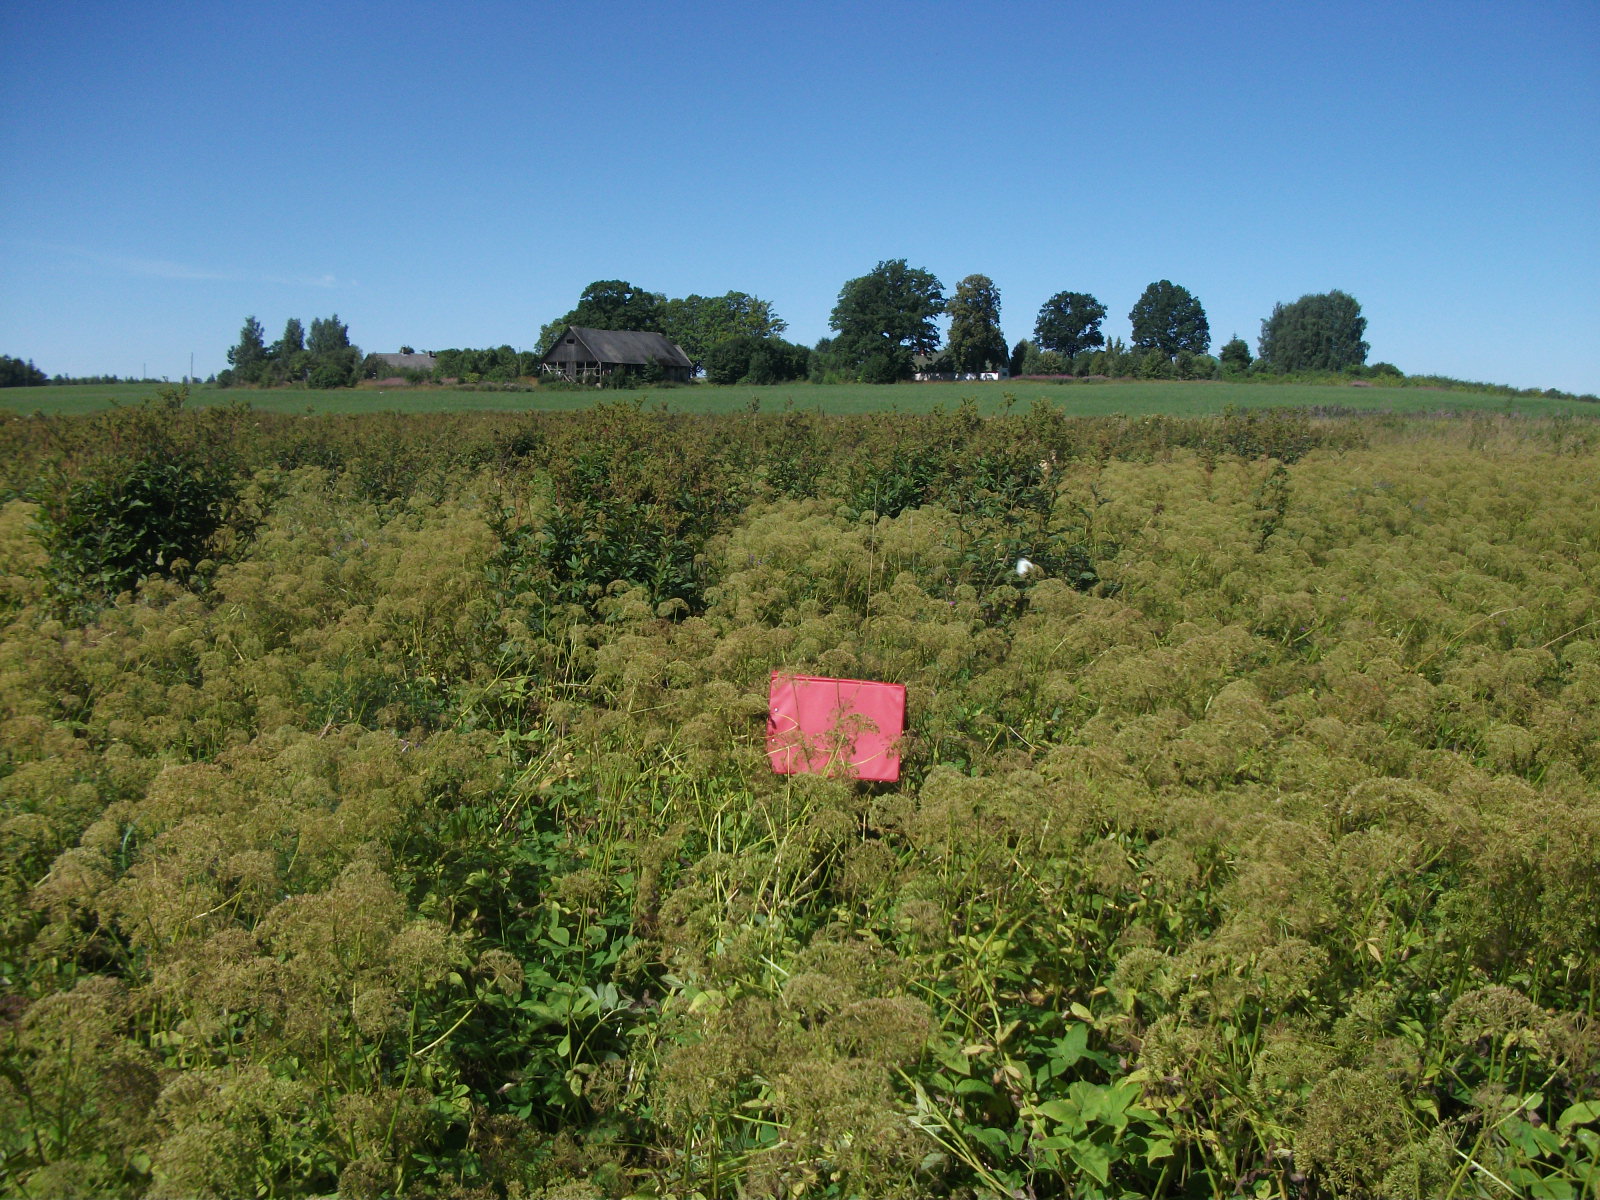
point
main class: Grassland
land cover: Spontaneously vegetated surfaces
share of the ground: > 75 %
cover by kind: herbaceous plants 100 %
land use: Abandoned areas
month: August
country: LV
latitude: 57.0265
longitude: 26.4705
